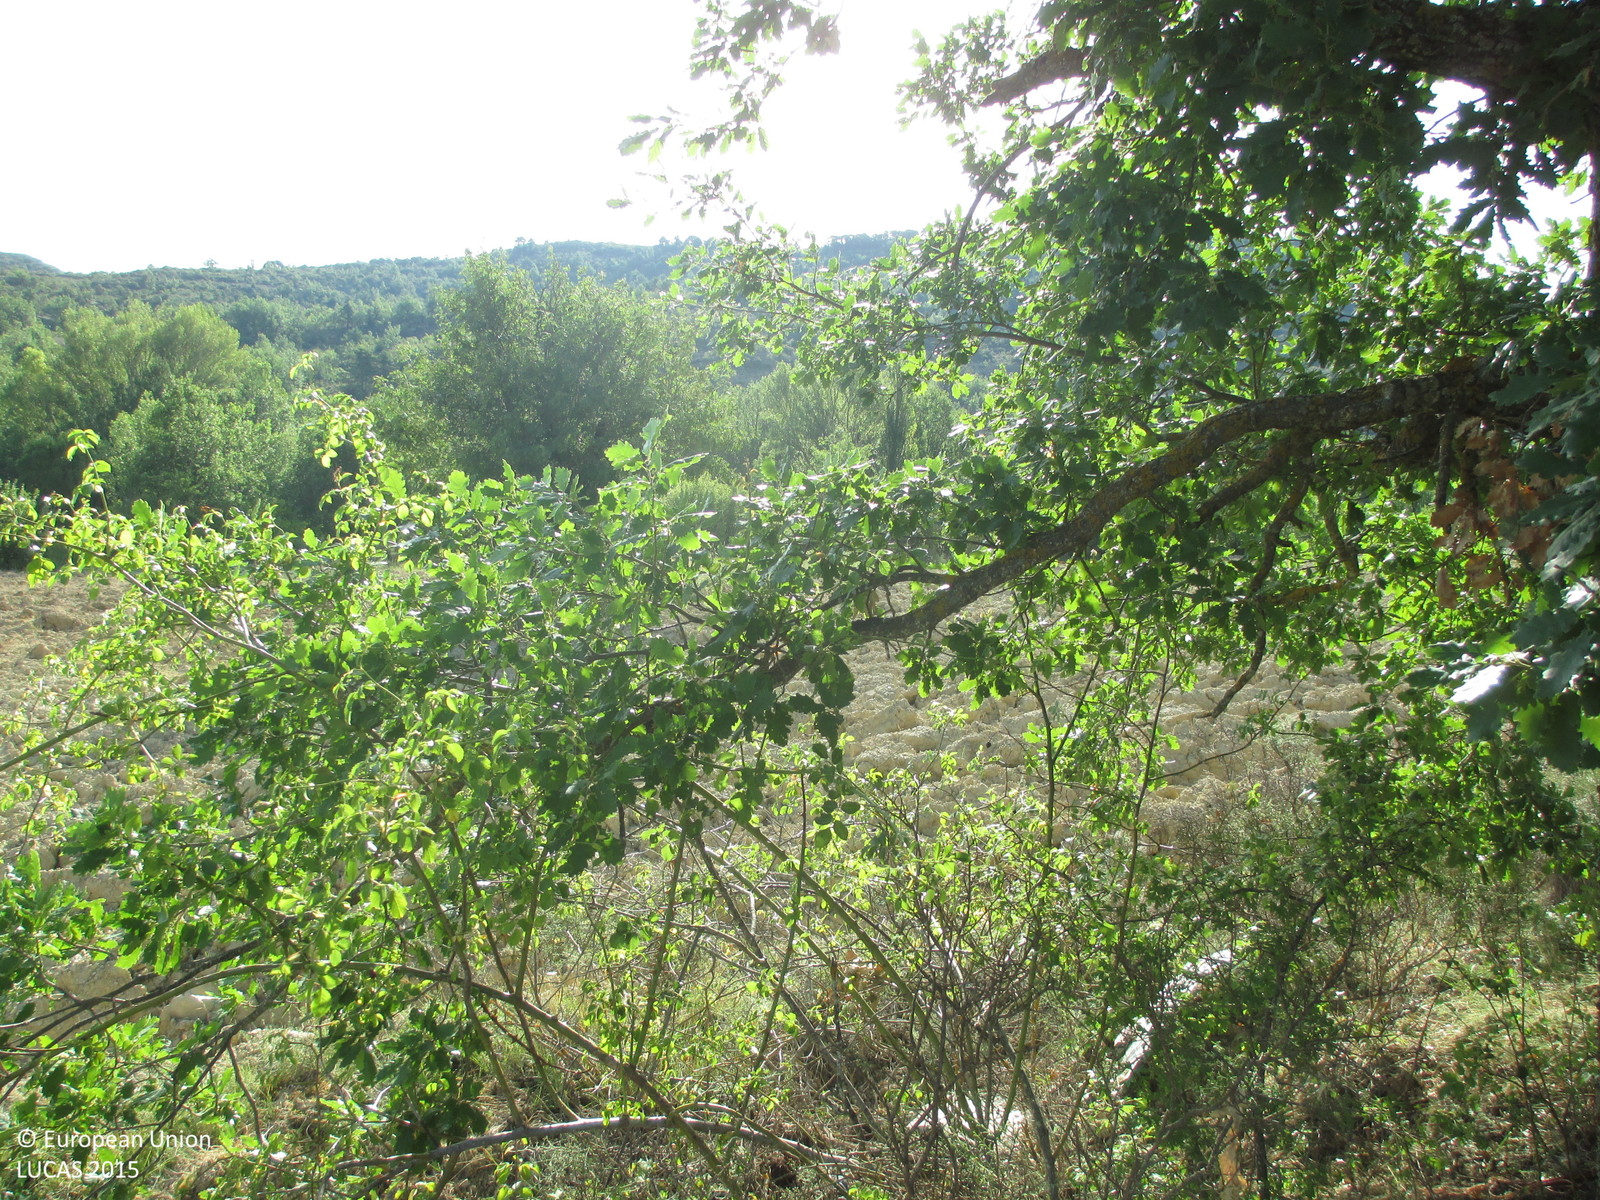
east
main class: Grassland
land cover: Grassland with sparse tree/shrub cover
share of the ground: > 75 %
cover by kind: herbaceous plants 90 %, broadleaved forest trees 5 %, shrubs 5 %
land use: Semi-natural and natural areas not in use
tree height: > 5 m
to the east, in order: Grassland with sparse tree/shrub cover; Other bare soil; Broadleaved woodland; Other bare soil; Broadleaved woodland; Rivers and streams; Broadleaved woodland; Fences; Grassland with sparse tree/shrub cover
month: July
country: ES
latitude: 42.3762
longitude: -0.3592
